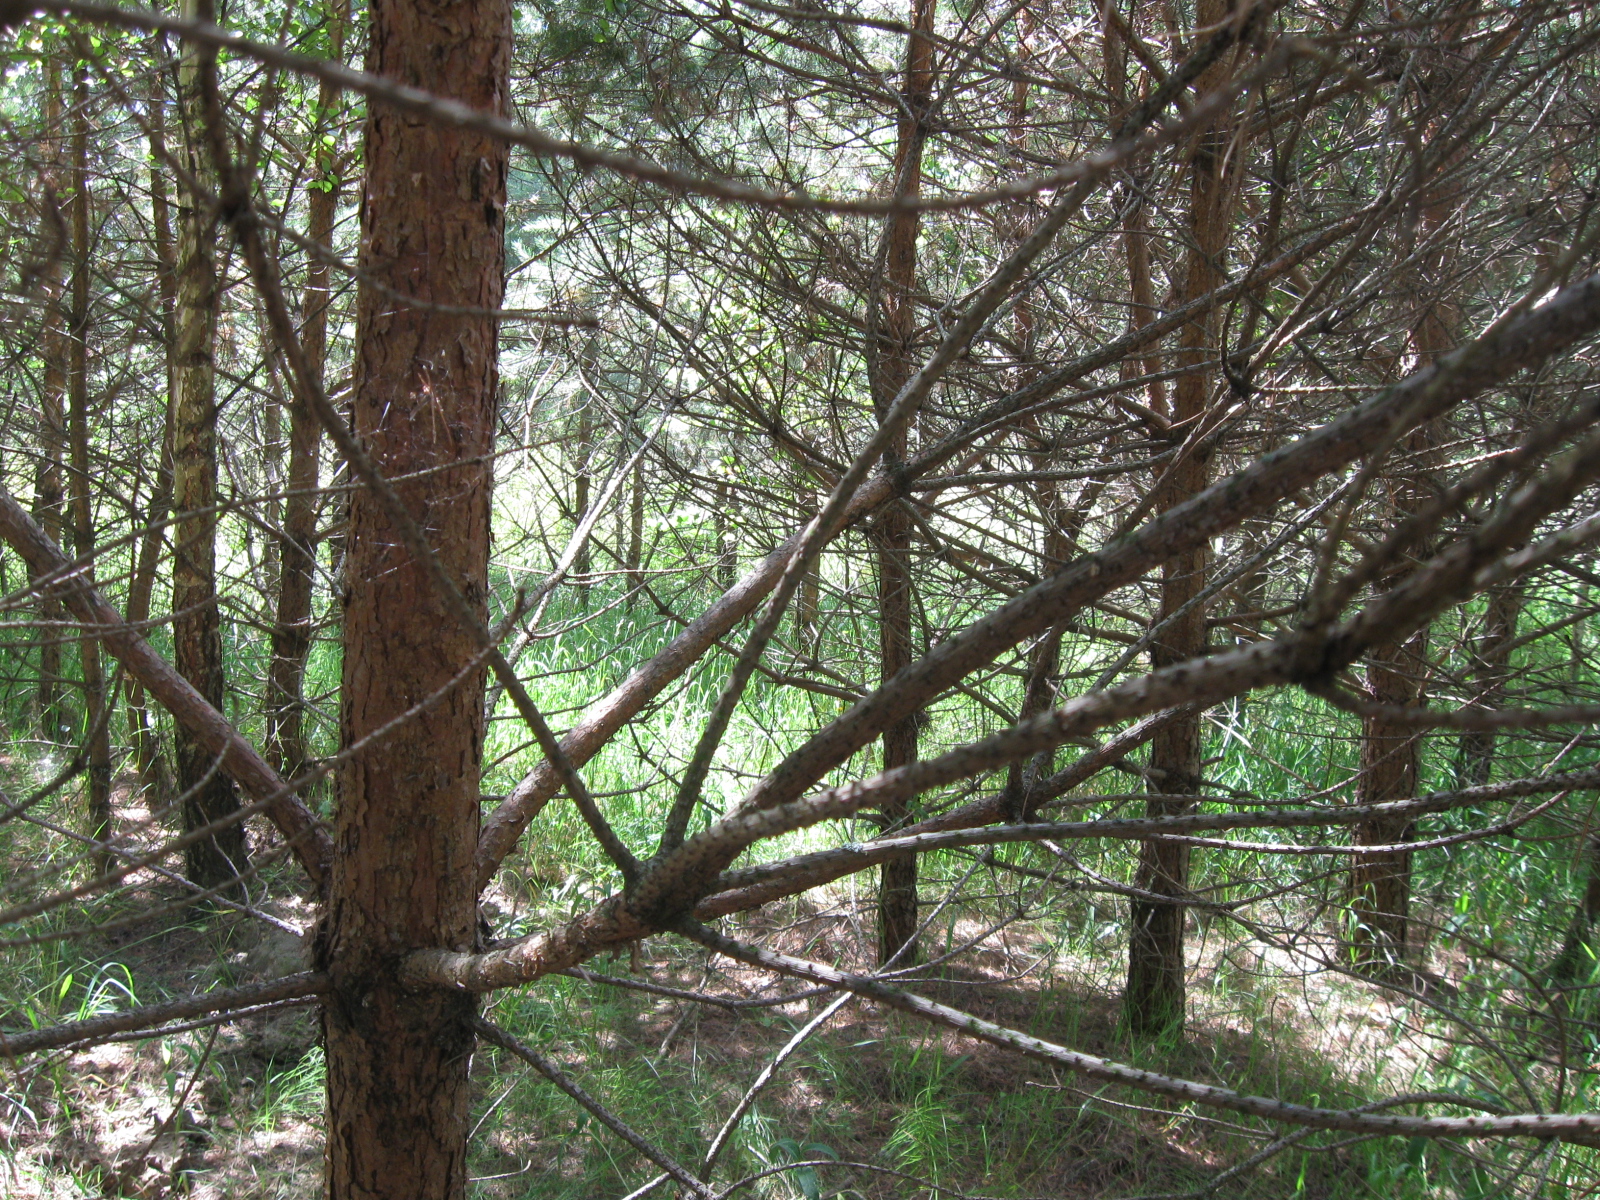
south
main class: Woodland
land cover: Pine dominated coniferous woodland
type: hemiboreal forest and nemoral coniferous forest and mixed broadleaved-coniferous forest
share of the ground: > 75 %
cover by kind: coniferous forest trees 95 %, herbaceous plants 5 %
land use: Forestry
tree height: < 5 m
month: July
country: LT
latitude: 54.3632
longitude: 24.5558
